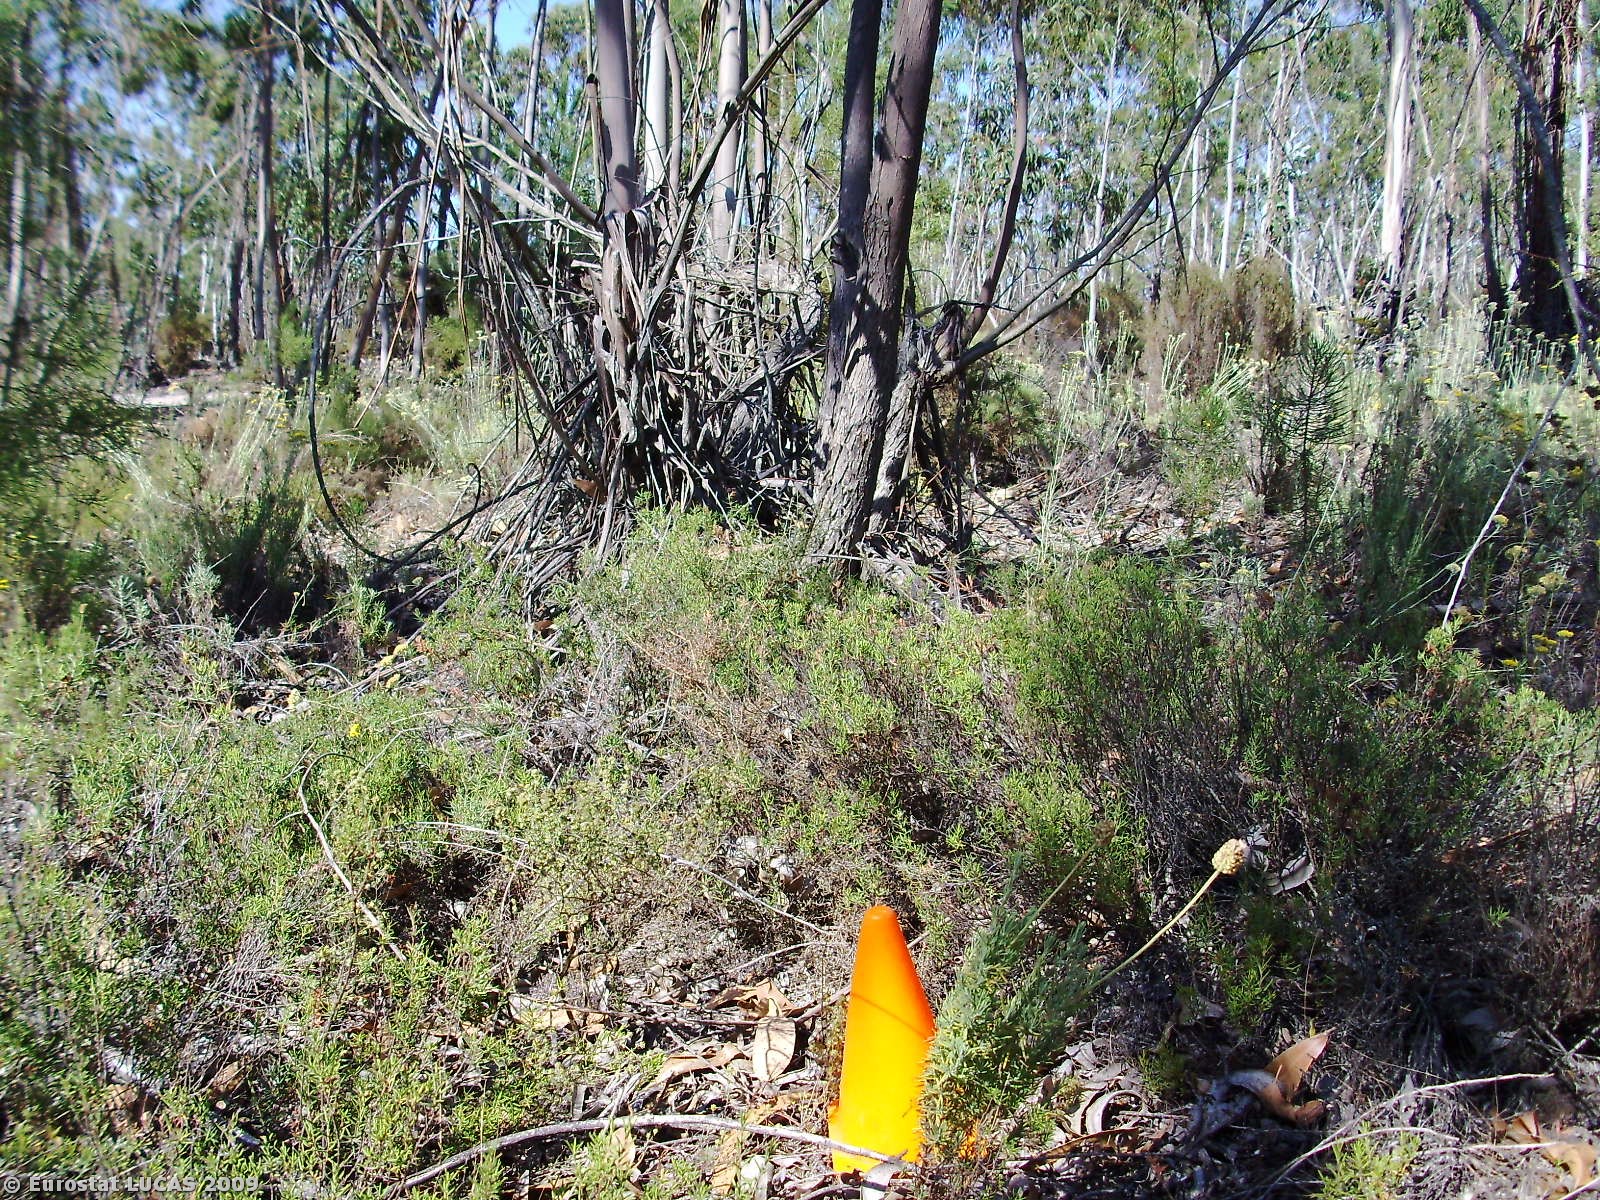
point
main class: Woodland
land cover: Broadleaved woodland
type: plantations and self-sown exotic forest
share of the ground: 50 - 75 %
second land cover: Shrubland with sparse tree cover
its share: 25 - 50 %
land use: Forestry
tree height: > 5 m
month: June
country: PT
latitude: 38.3108
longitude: -8.6607
